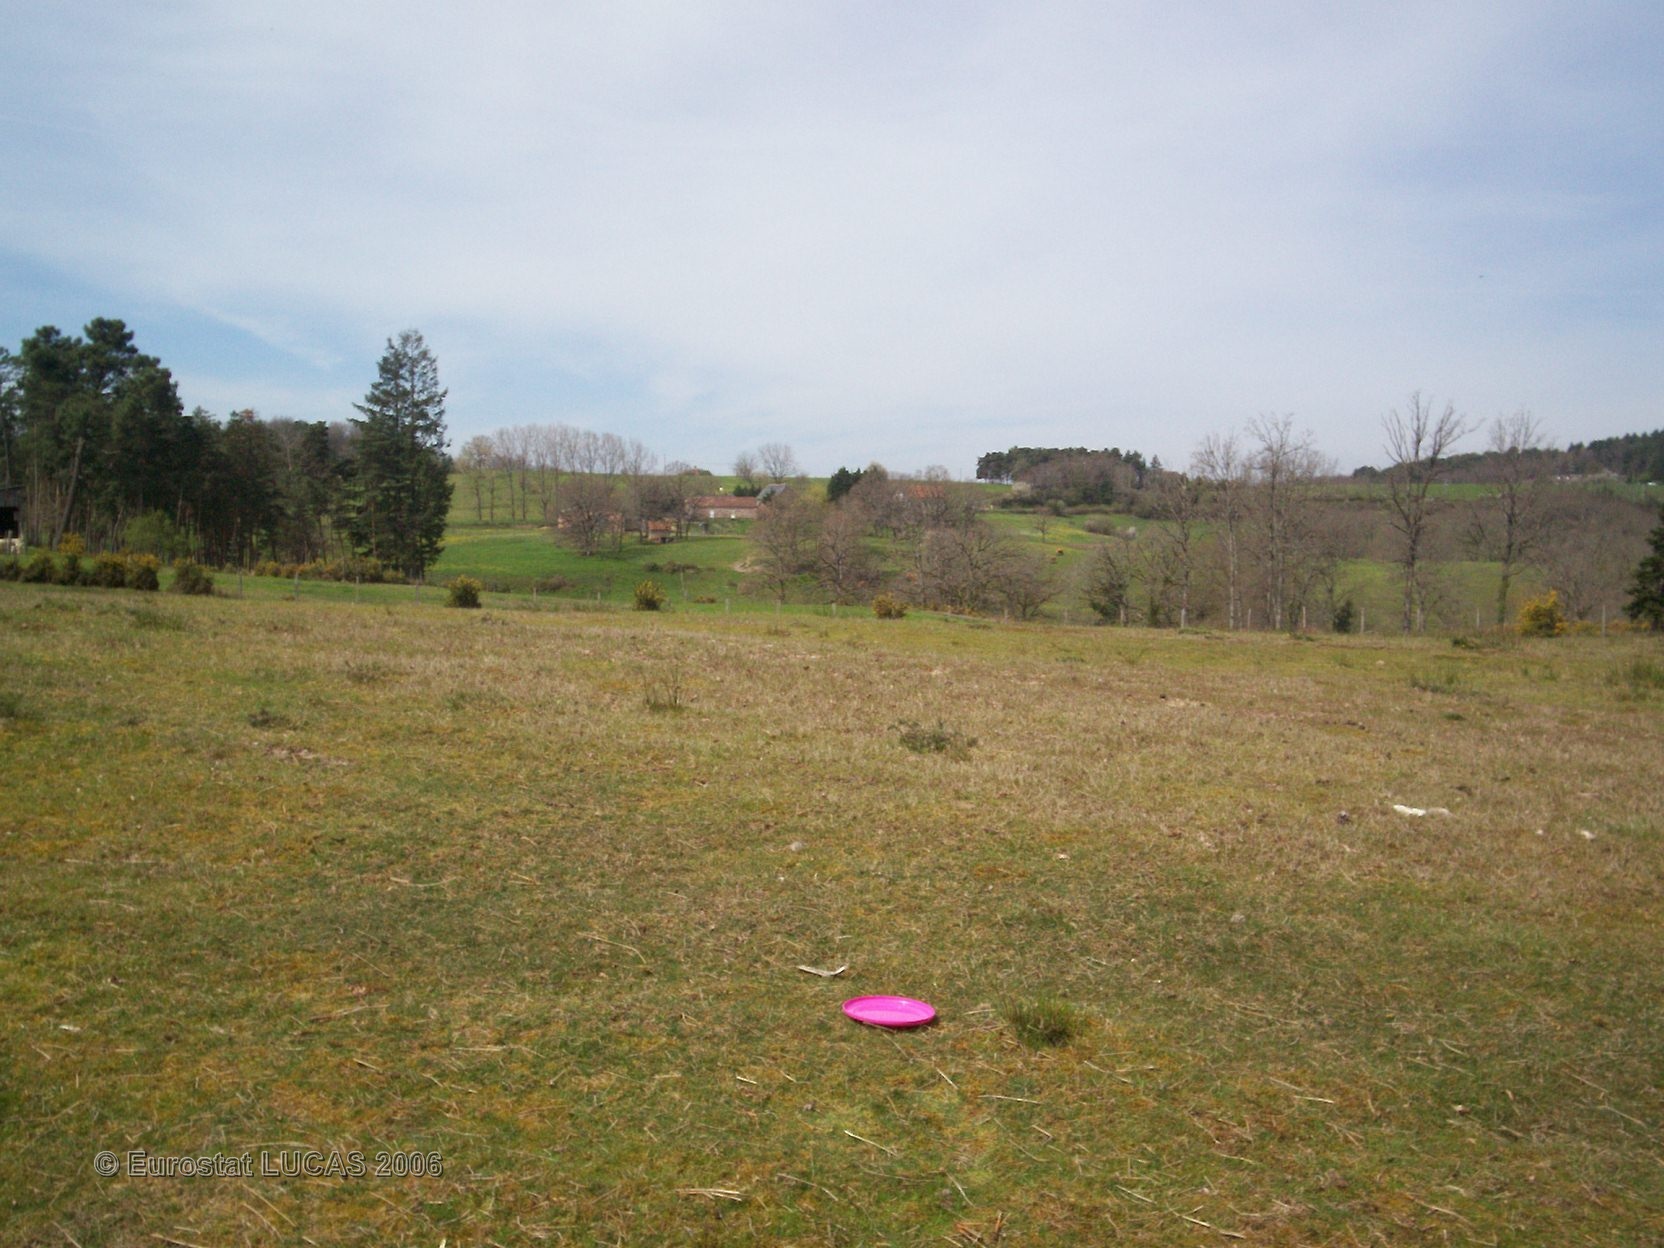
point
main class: Grassland
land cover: Grassland without tree/shrub cover
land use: Agriculture (excluding fallow land and kitchen gardens)
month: April
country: FR
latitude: 45.1811
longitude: 1.3020
